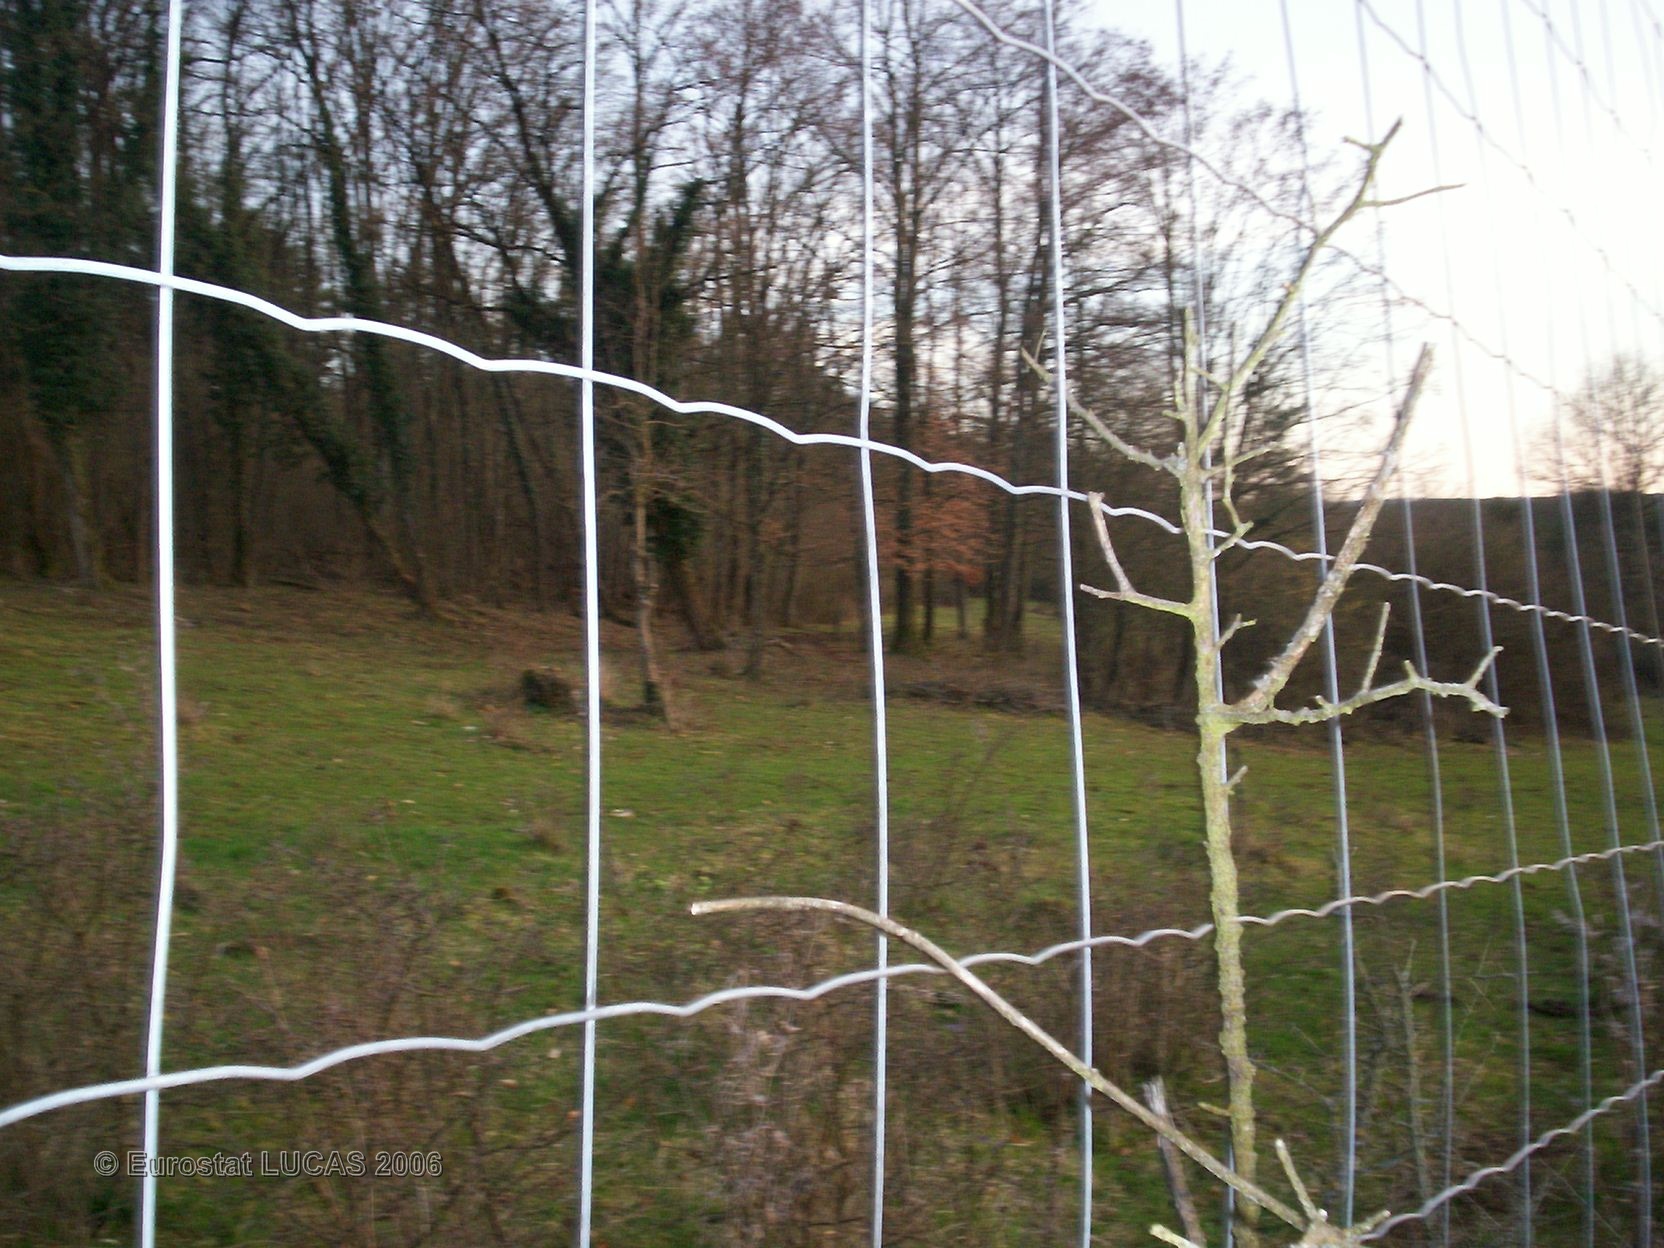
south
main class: Grassland
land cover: Grassland with sparse tree/shrub cover
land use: Agriculture (excluding fallow land and kitchen gardens)
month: April
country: FR
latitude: 48.3537
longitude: 5.2083
